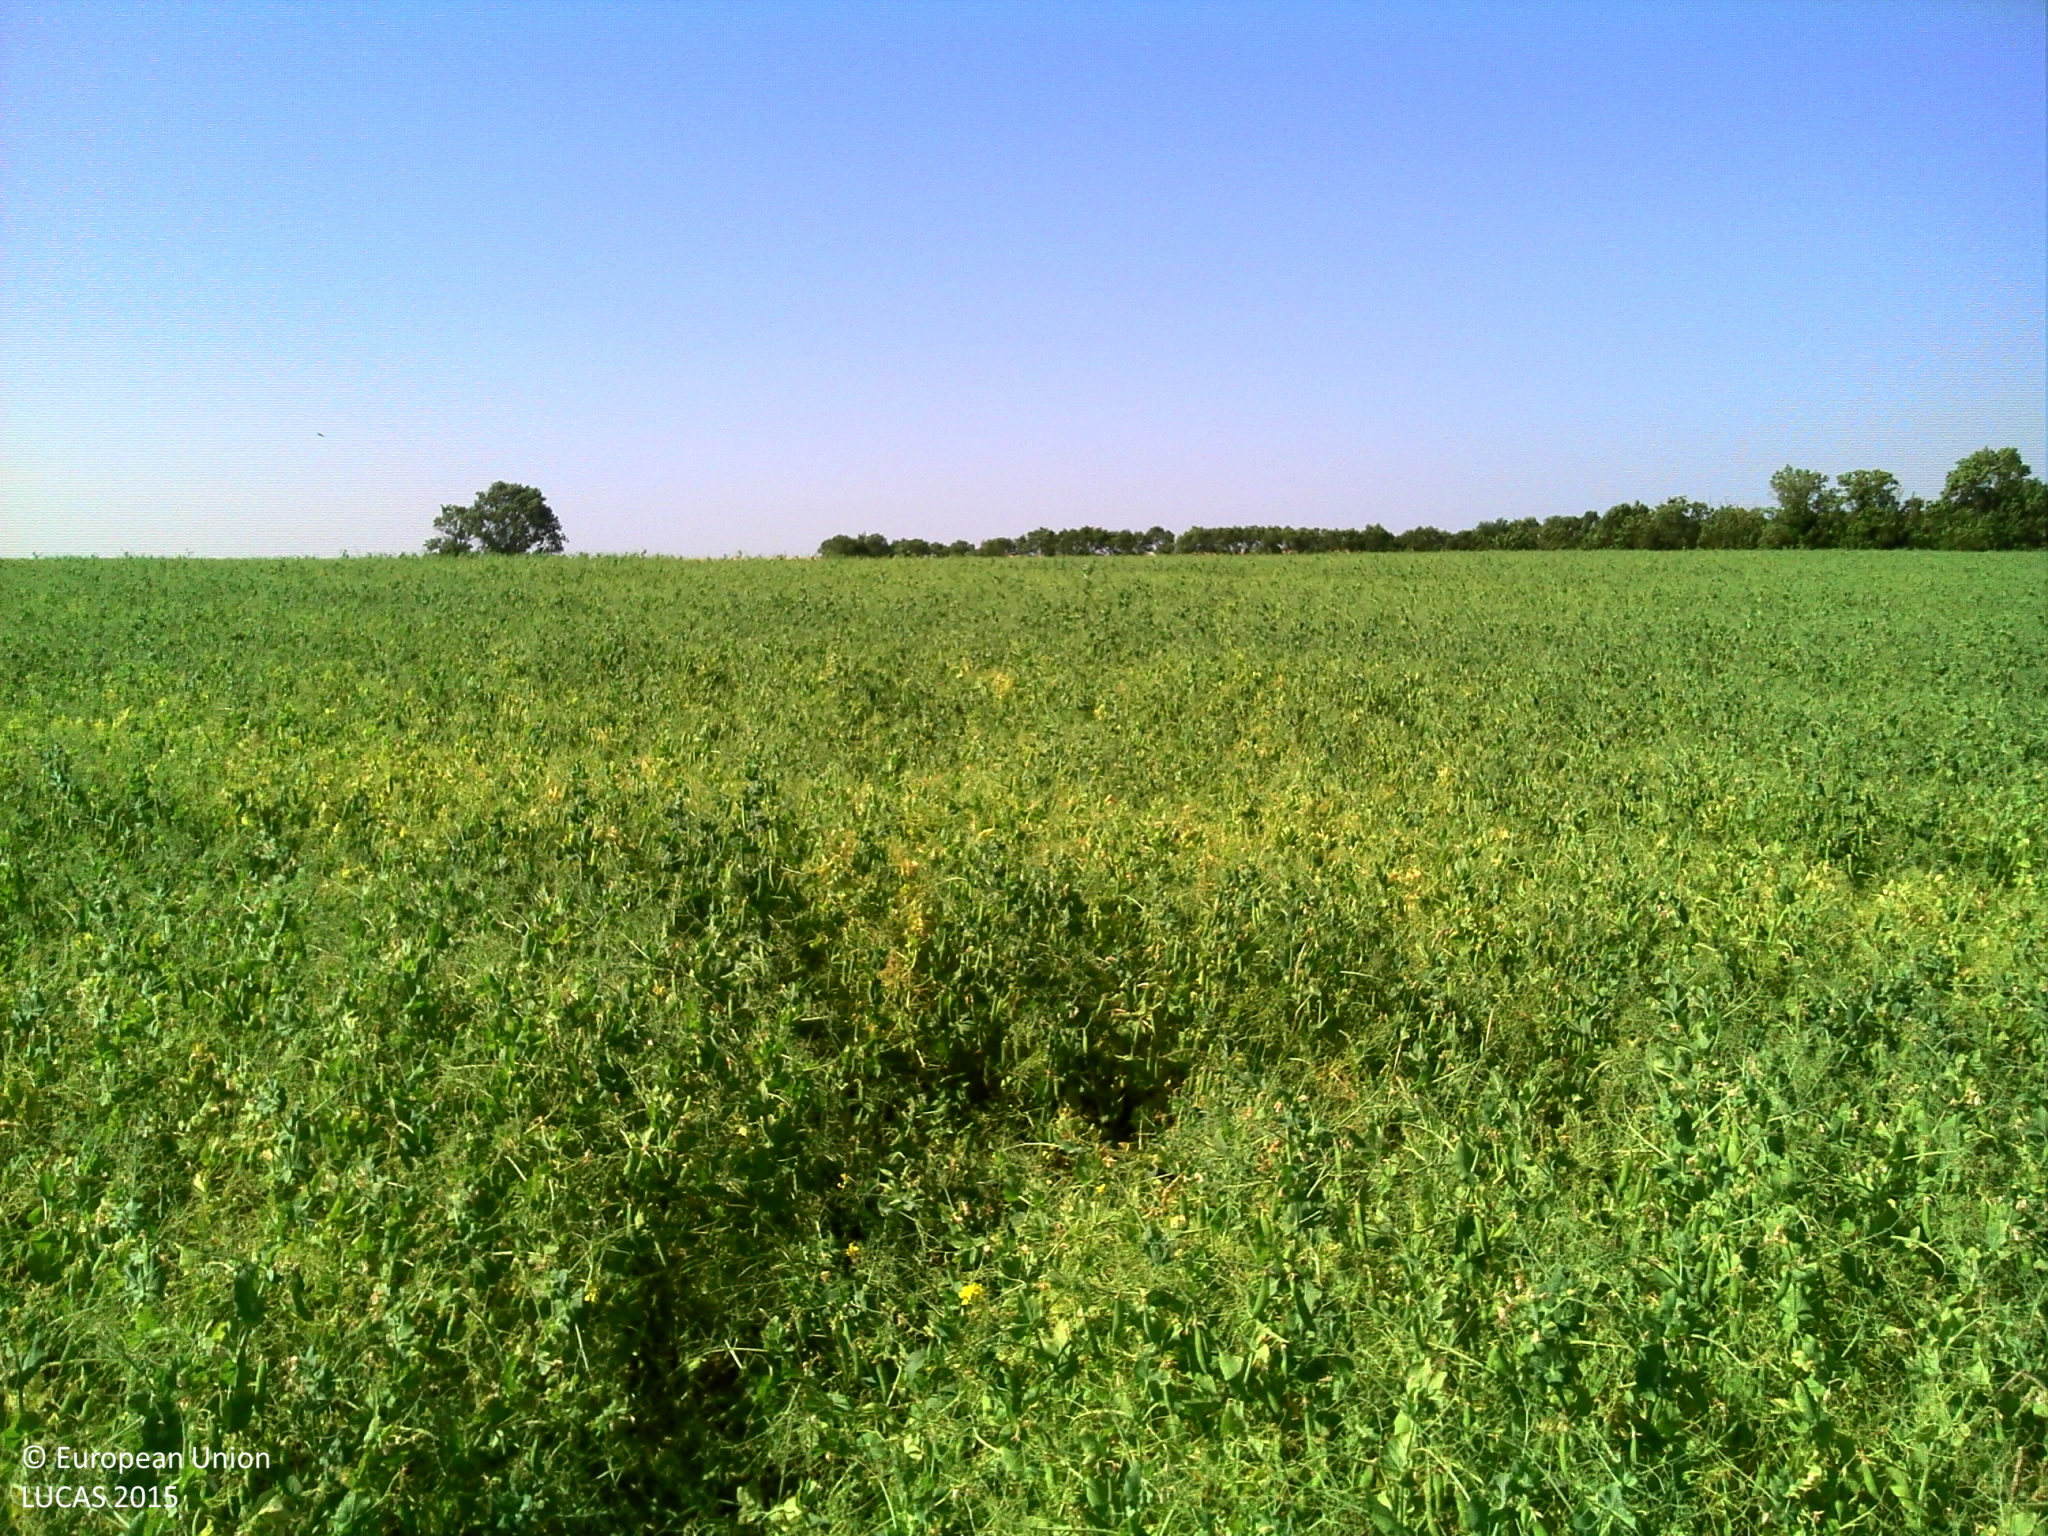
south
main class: Cropland
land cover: Dry pulses
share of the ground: > 75 %
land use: Agriculture (excluding fallow land and kitchen gardens)
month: June
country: FR
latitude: 46.2019
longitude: -0.9811
